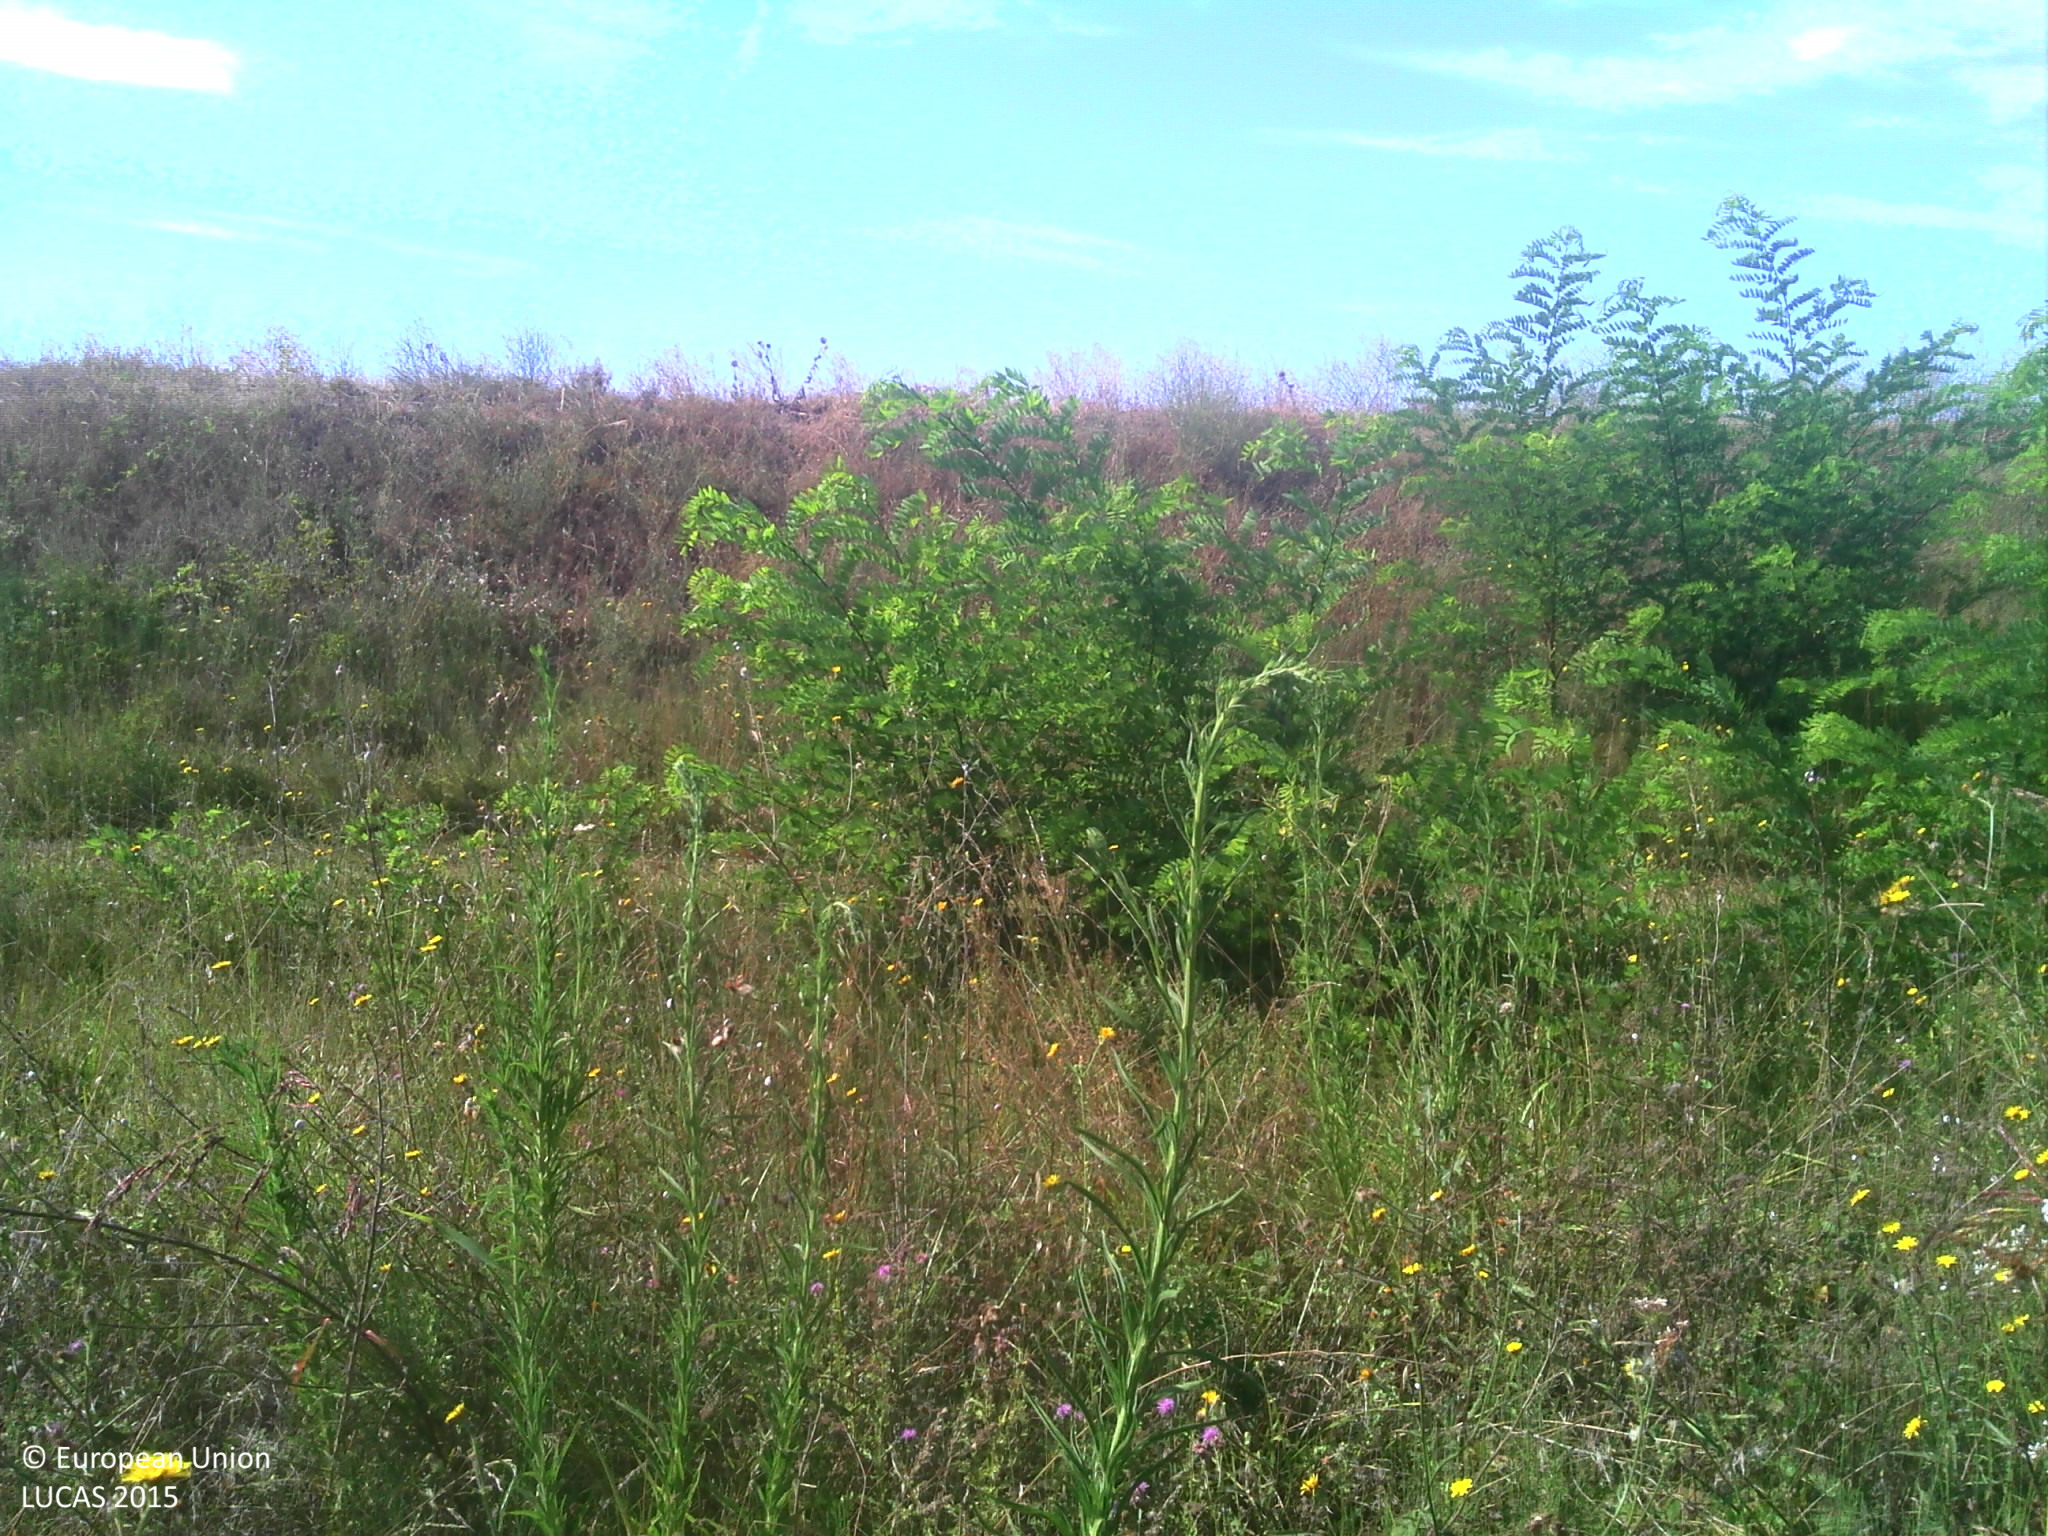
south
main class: Grassland
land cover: Grassland with sparse tree/shrub cover
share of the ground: > 75 %
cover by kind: herbaceous plants 85 %, broadleaved forest trees 5 %, shrubs 5 %, consolidated bare surface 5 %
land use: Fallow land
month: July
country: FR
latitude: 43.7372
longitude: 5.2786
